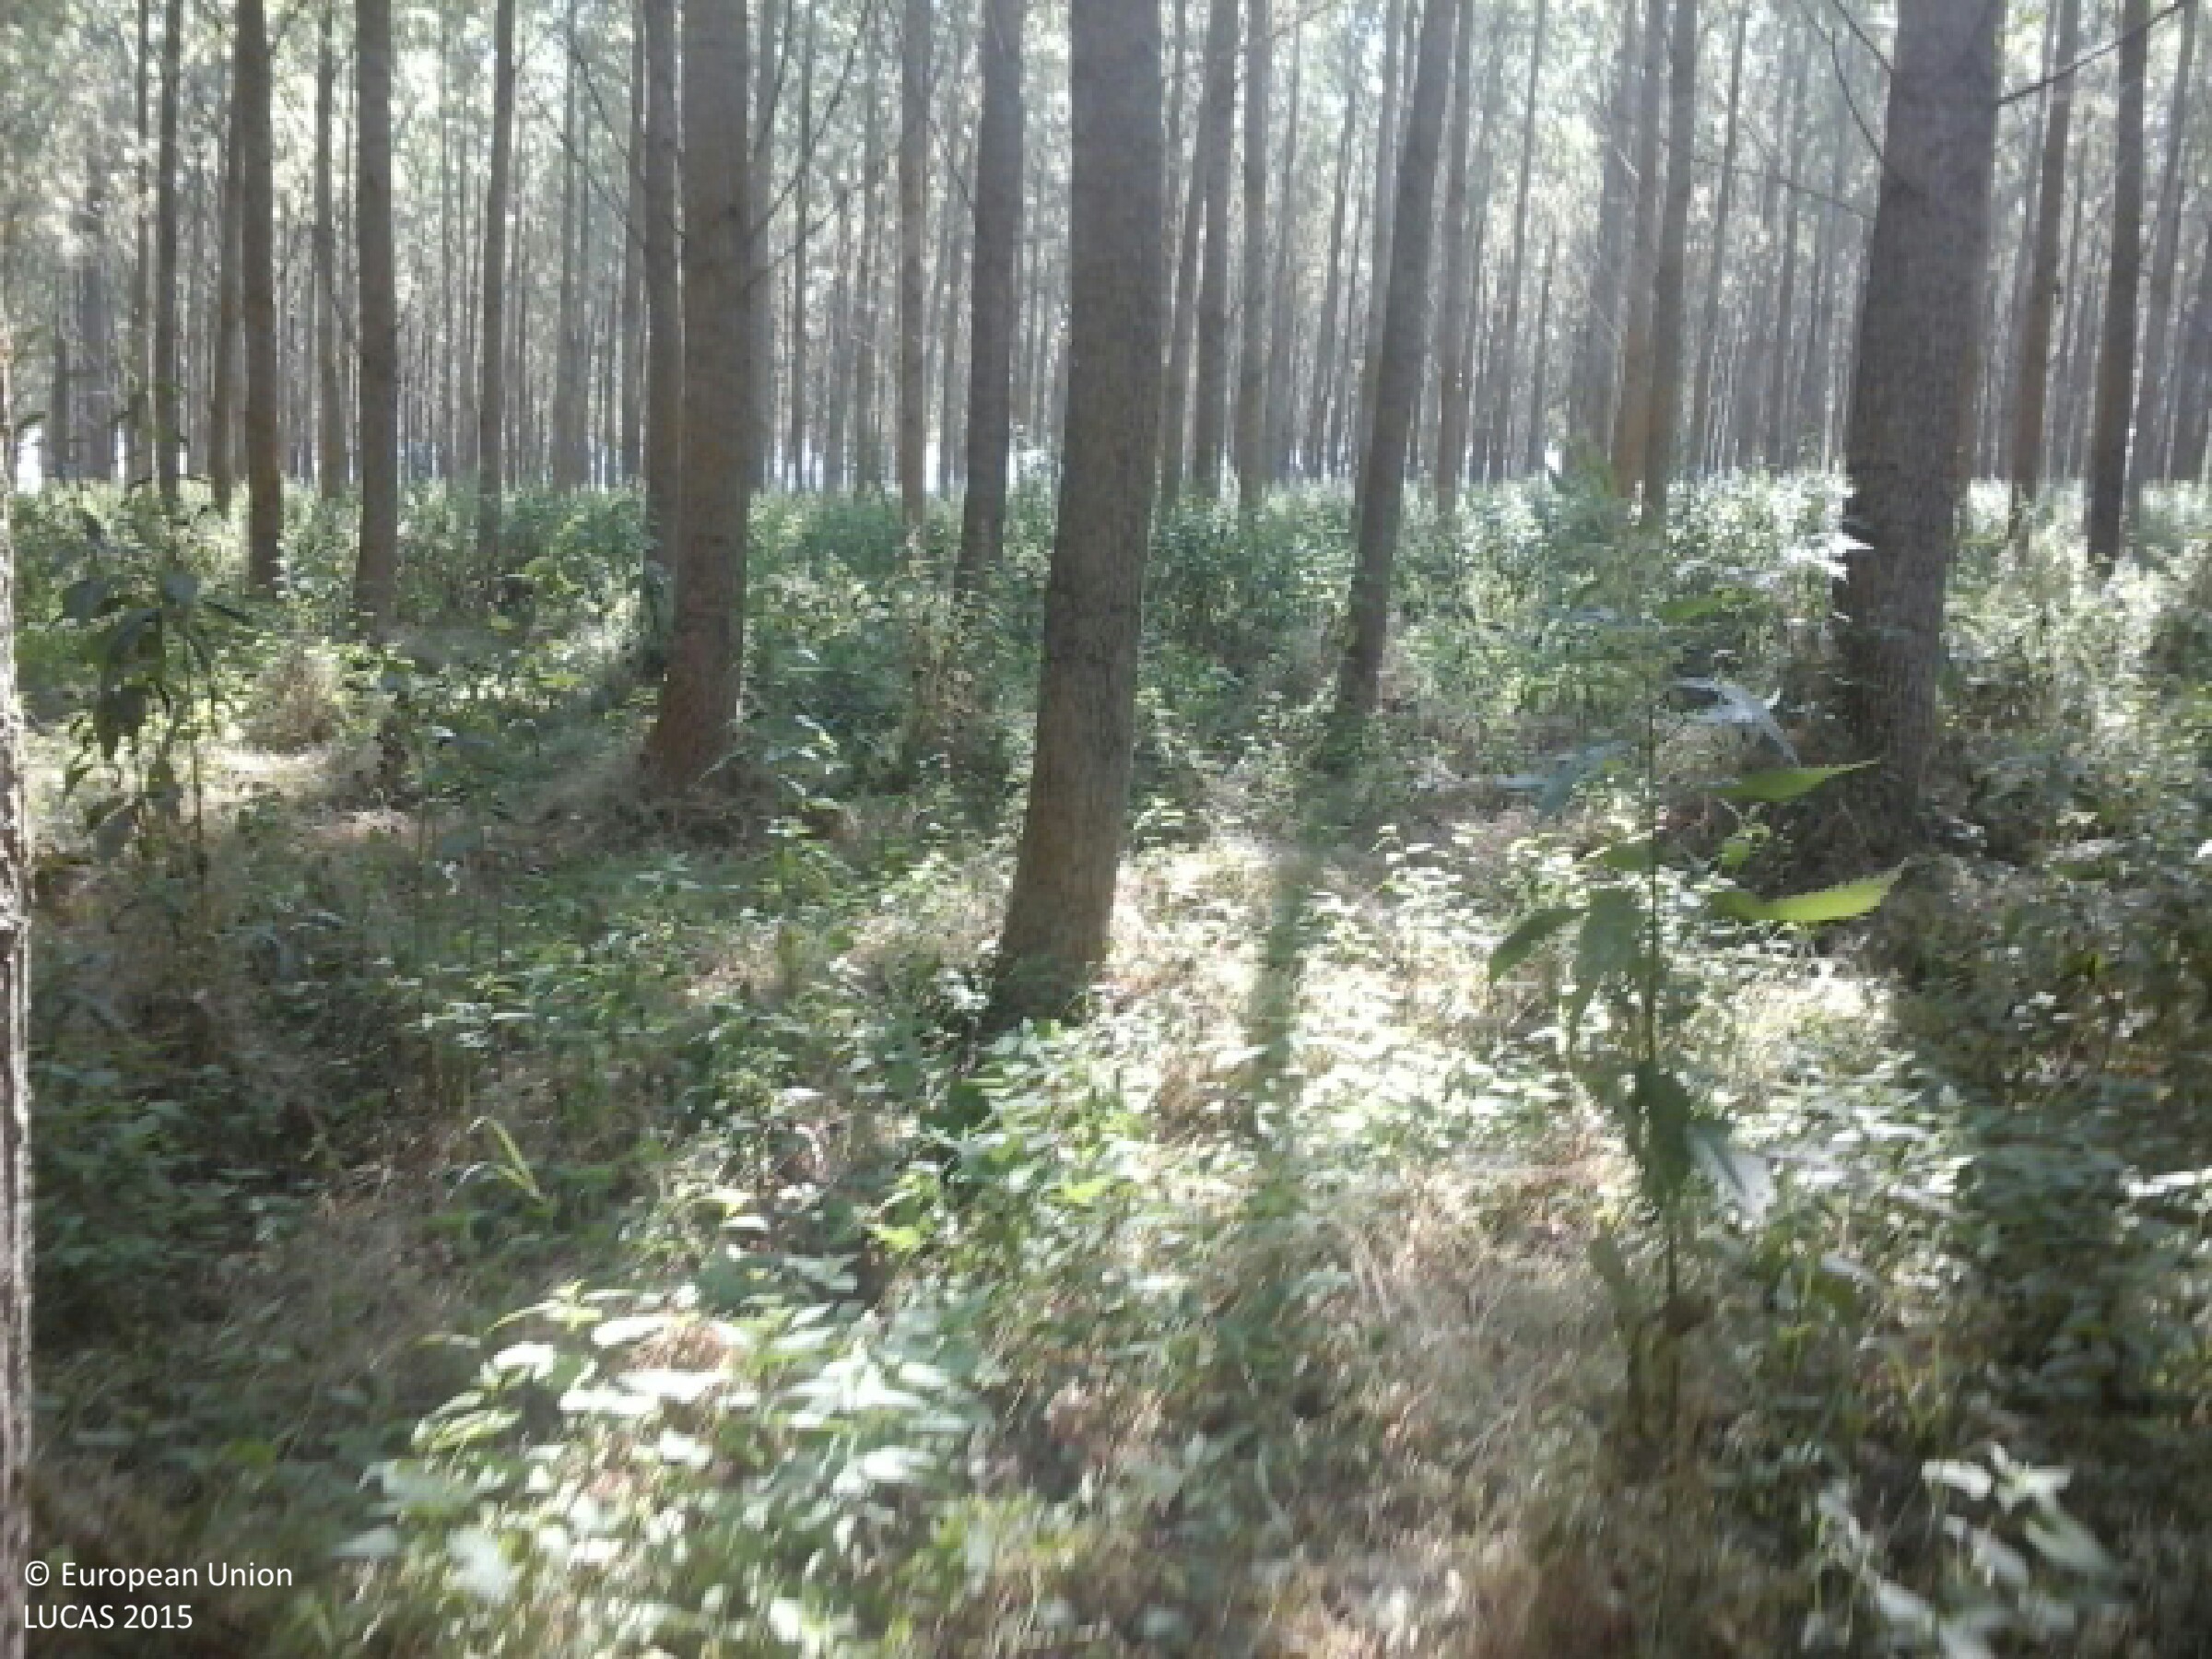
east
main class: Woodland
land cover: Broadleaved woodland
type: non-riverine alder, birch or aspen forest
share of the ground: > 75 %
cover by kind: broadleaved forest trees 95 %, herbaceous plants 5 %
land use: Forestry
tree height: > 5 m
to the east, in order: Broadleaved woodland
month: June
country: HU
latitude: 48.1795
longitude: 21.8728
